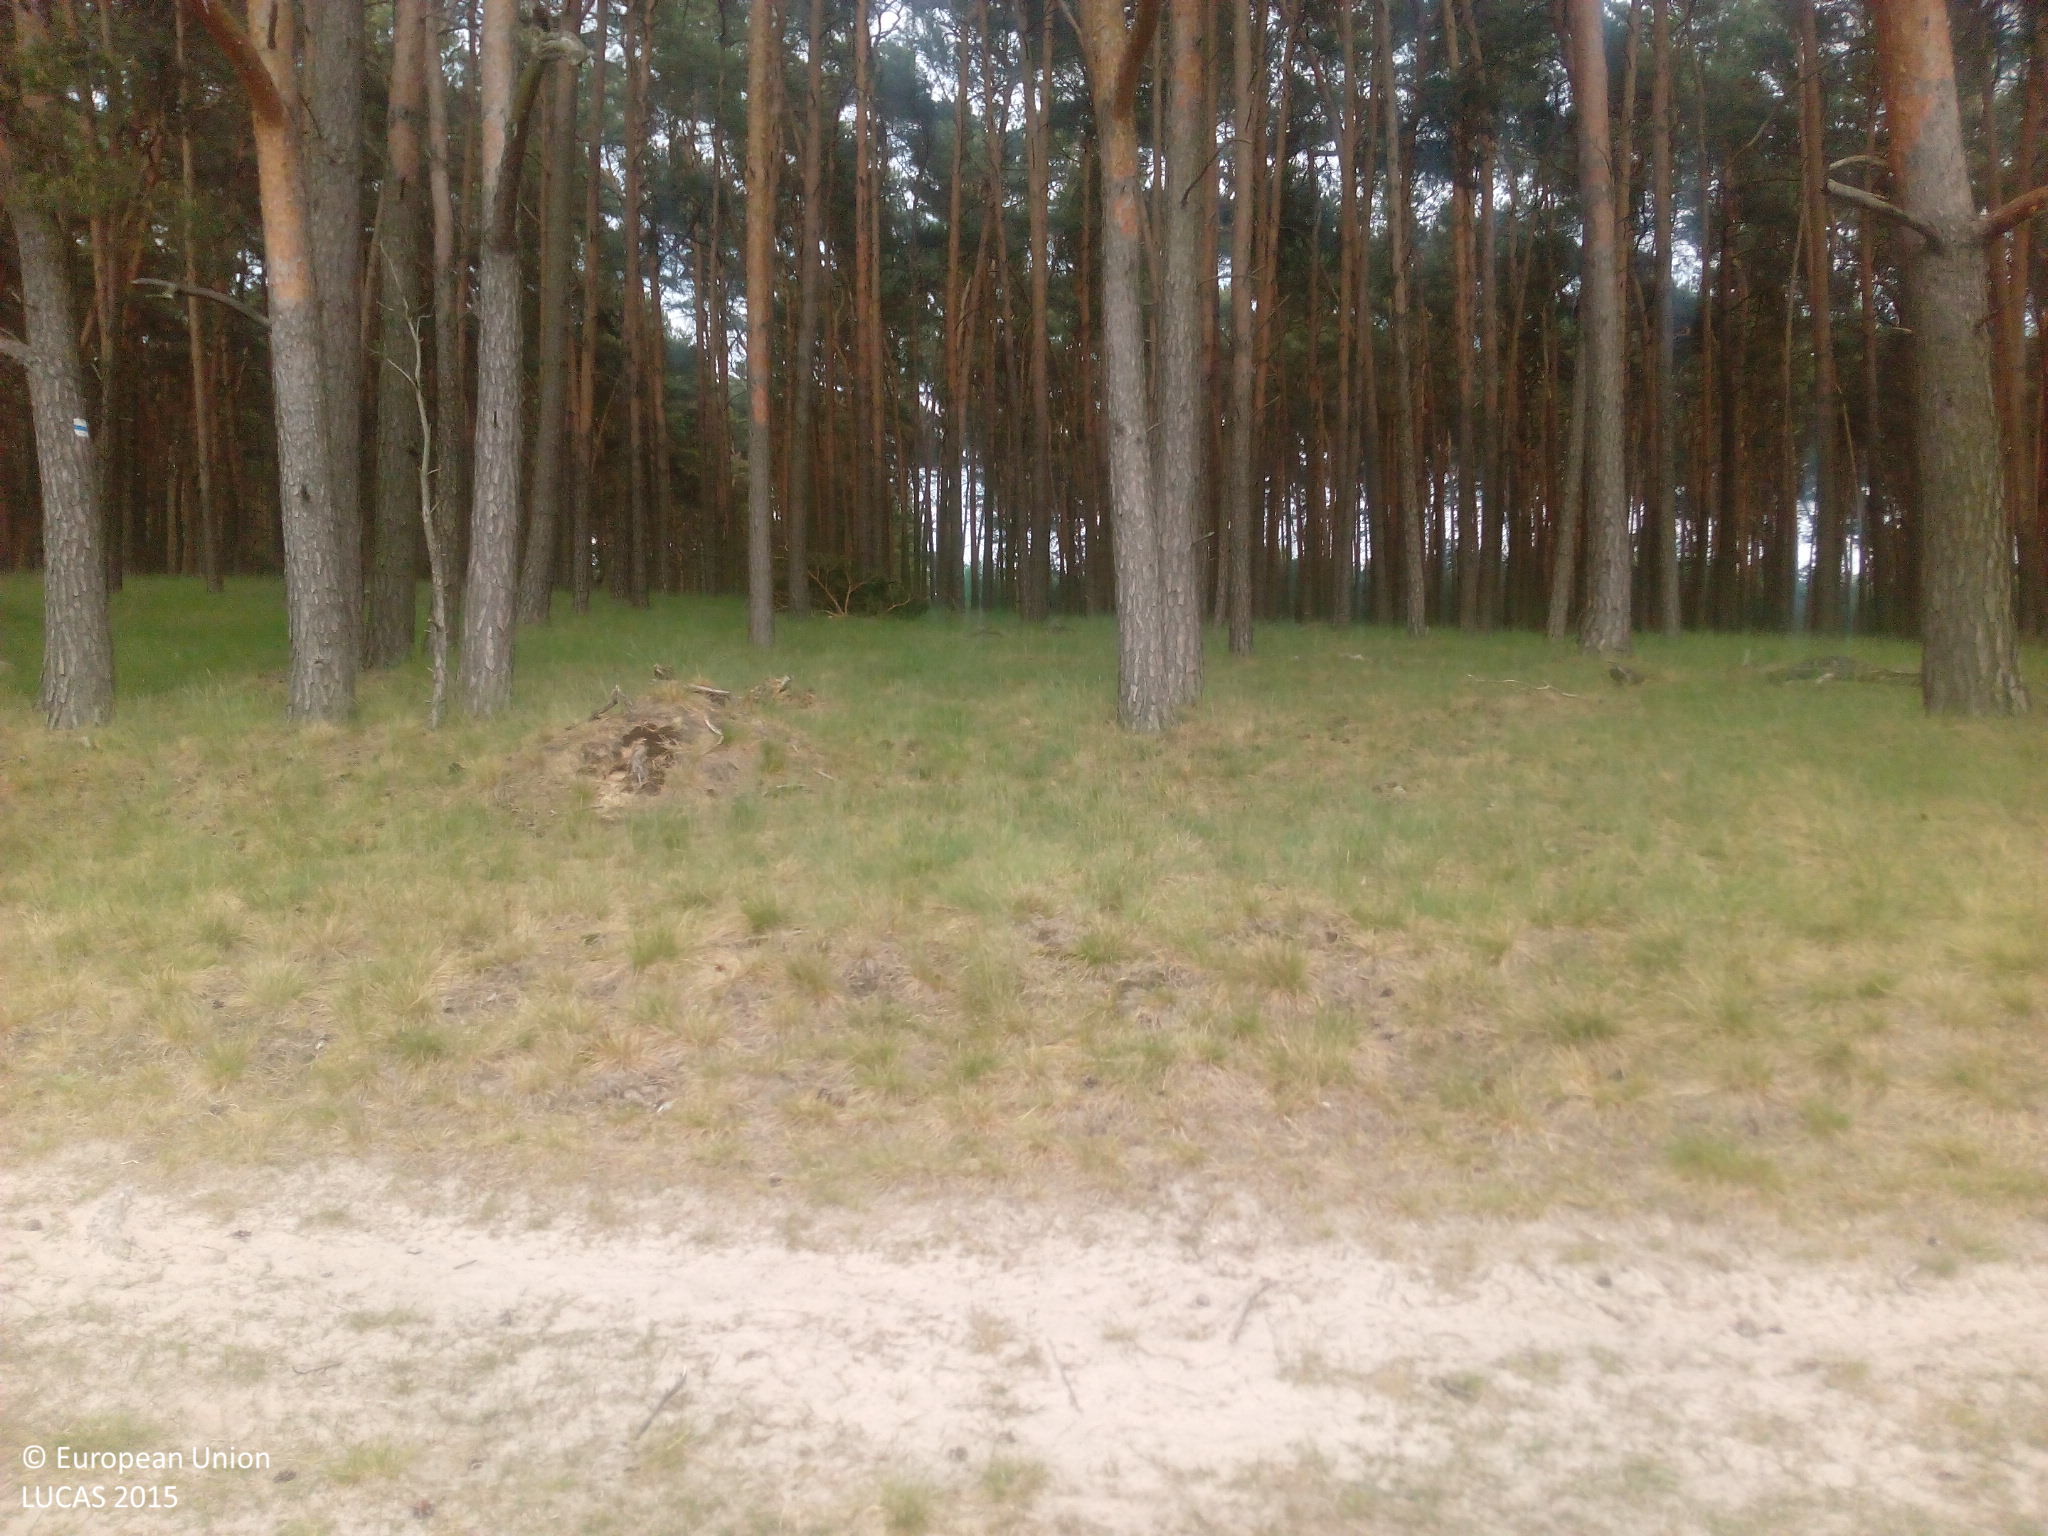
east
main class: Cropland
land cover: Rye
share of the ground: > 75 %
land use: Agriculture (excluding fallow land and kitchen gardens)
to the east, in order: Rye; Grass margins; Tracks; Pine dominated coniferous woodland
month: May
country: DE
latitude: 52.2473
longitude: 13.0904
